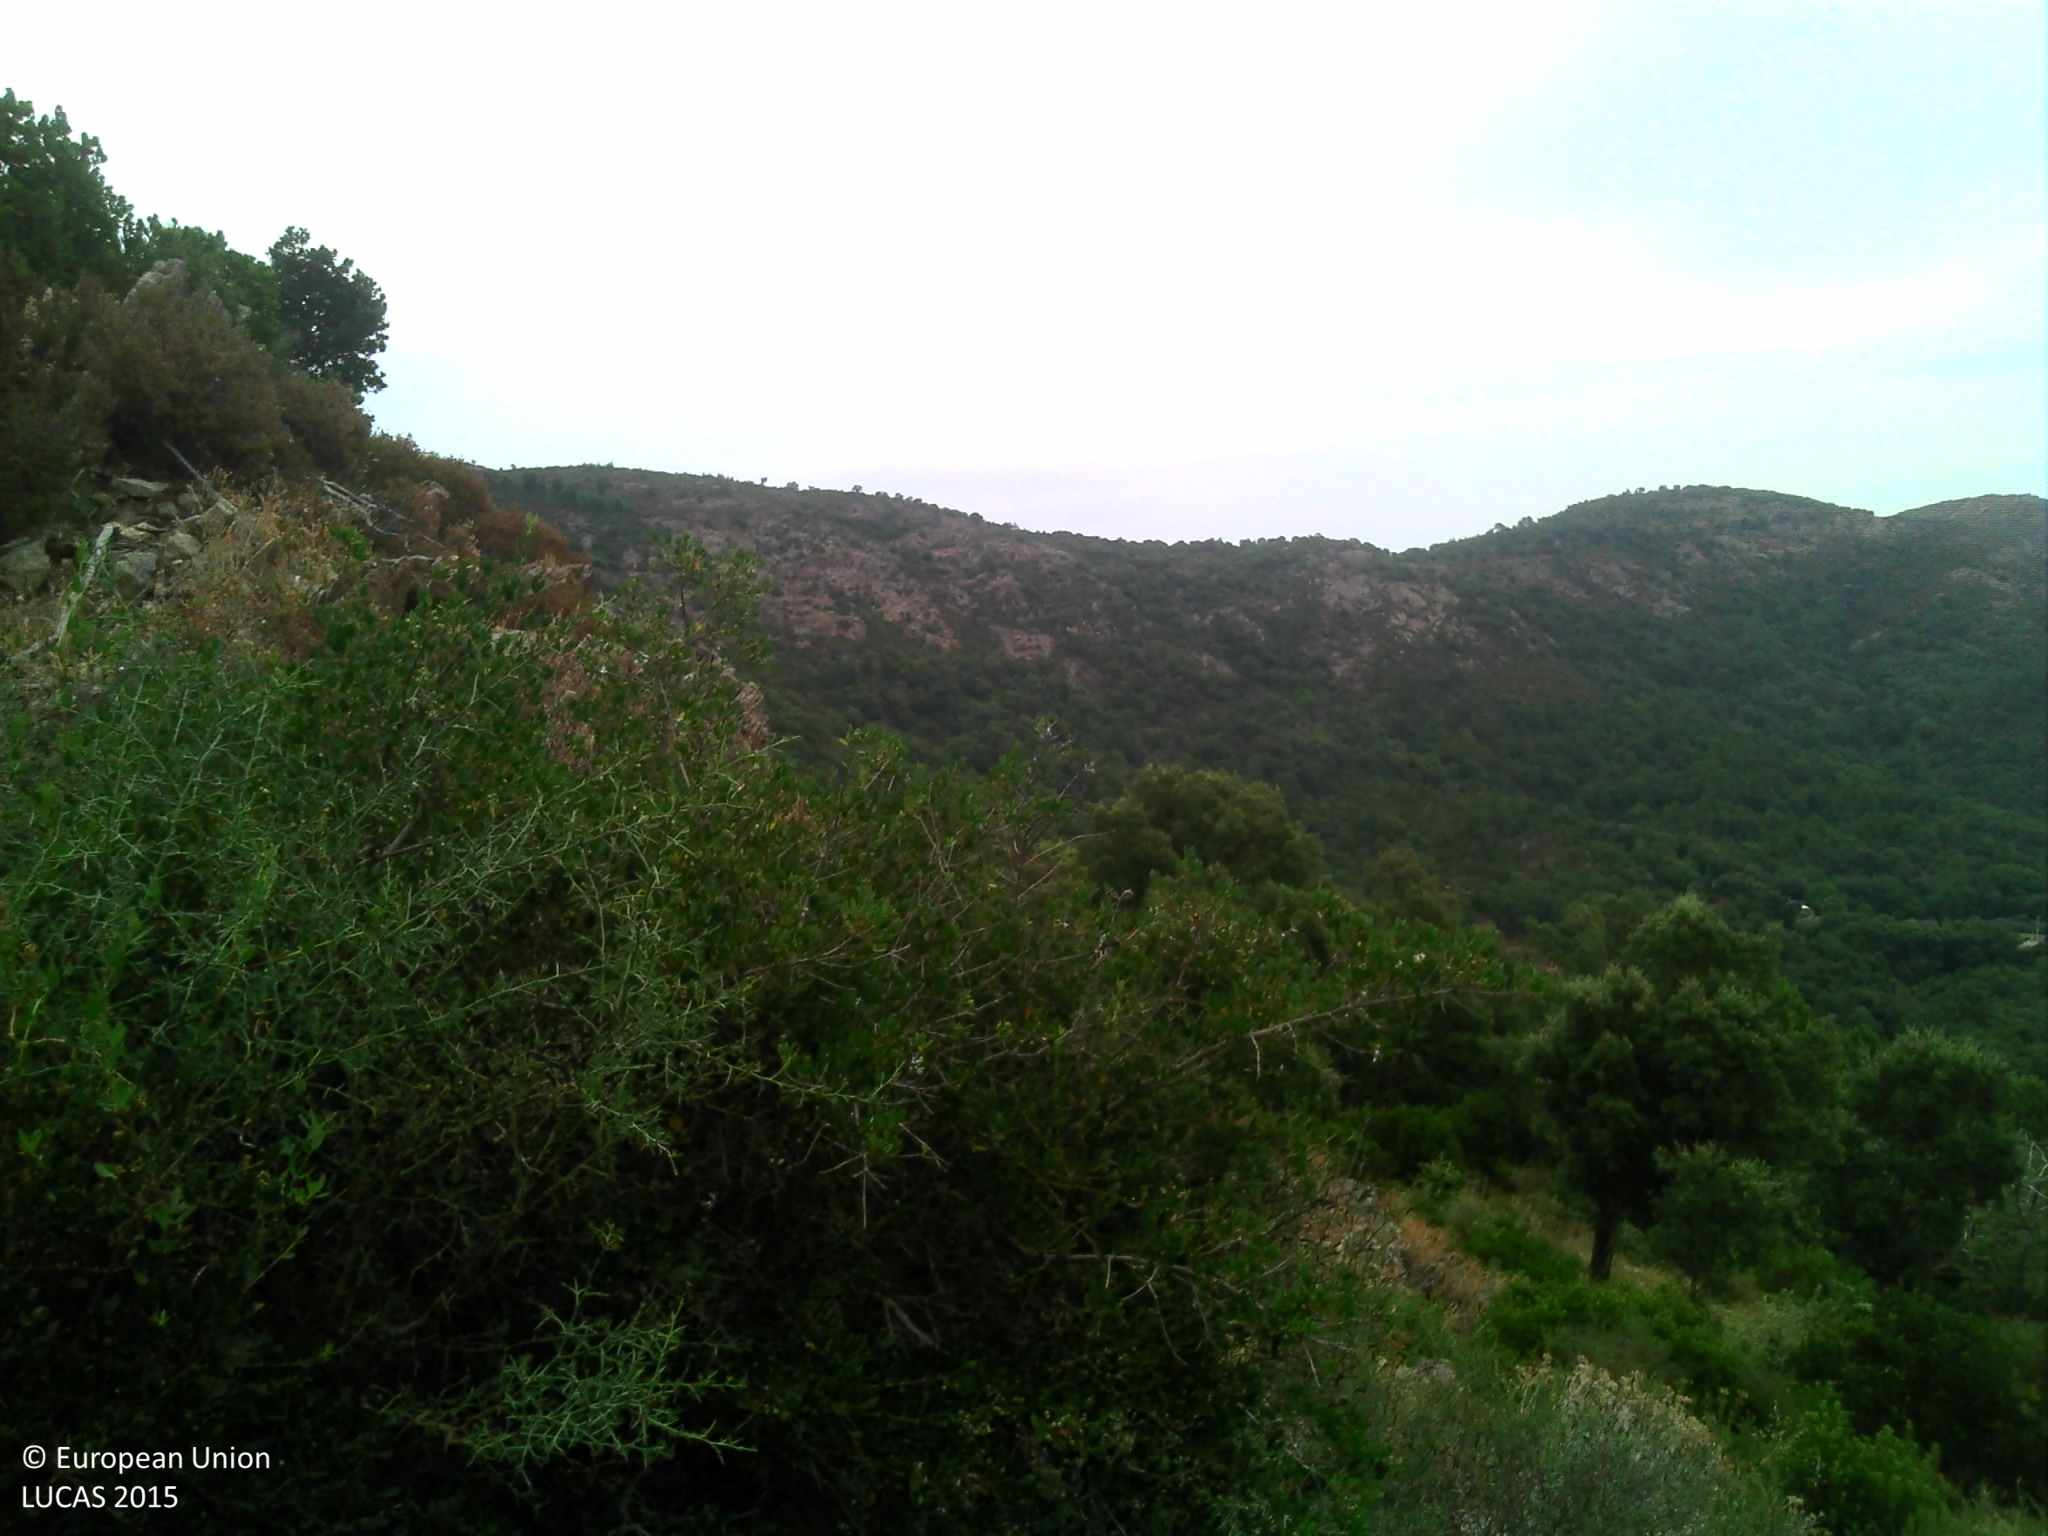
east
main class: Shrubland
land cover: Shrubland without tree cover
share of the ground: > 75 %
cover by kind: shrubs 80 %, unconsolidated bare surface 20 %
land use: Semi-natural and natural areas not in use
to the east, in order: Shrubland without tree cover; Broadleaved woodland; Tracks; Broadleaved woodland; Tracks; Broadleaved woodland; Tracks; Broadleaved woodland; Tracks; Broadleaved woodland
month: July
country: FR
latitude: 43.2956
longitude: 6.4222
